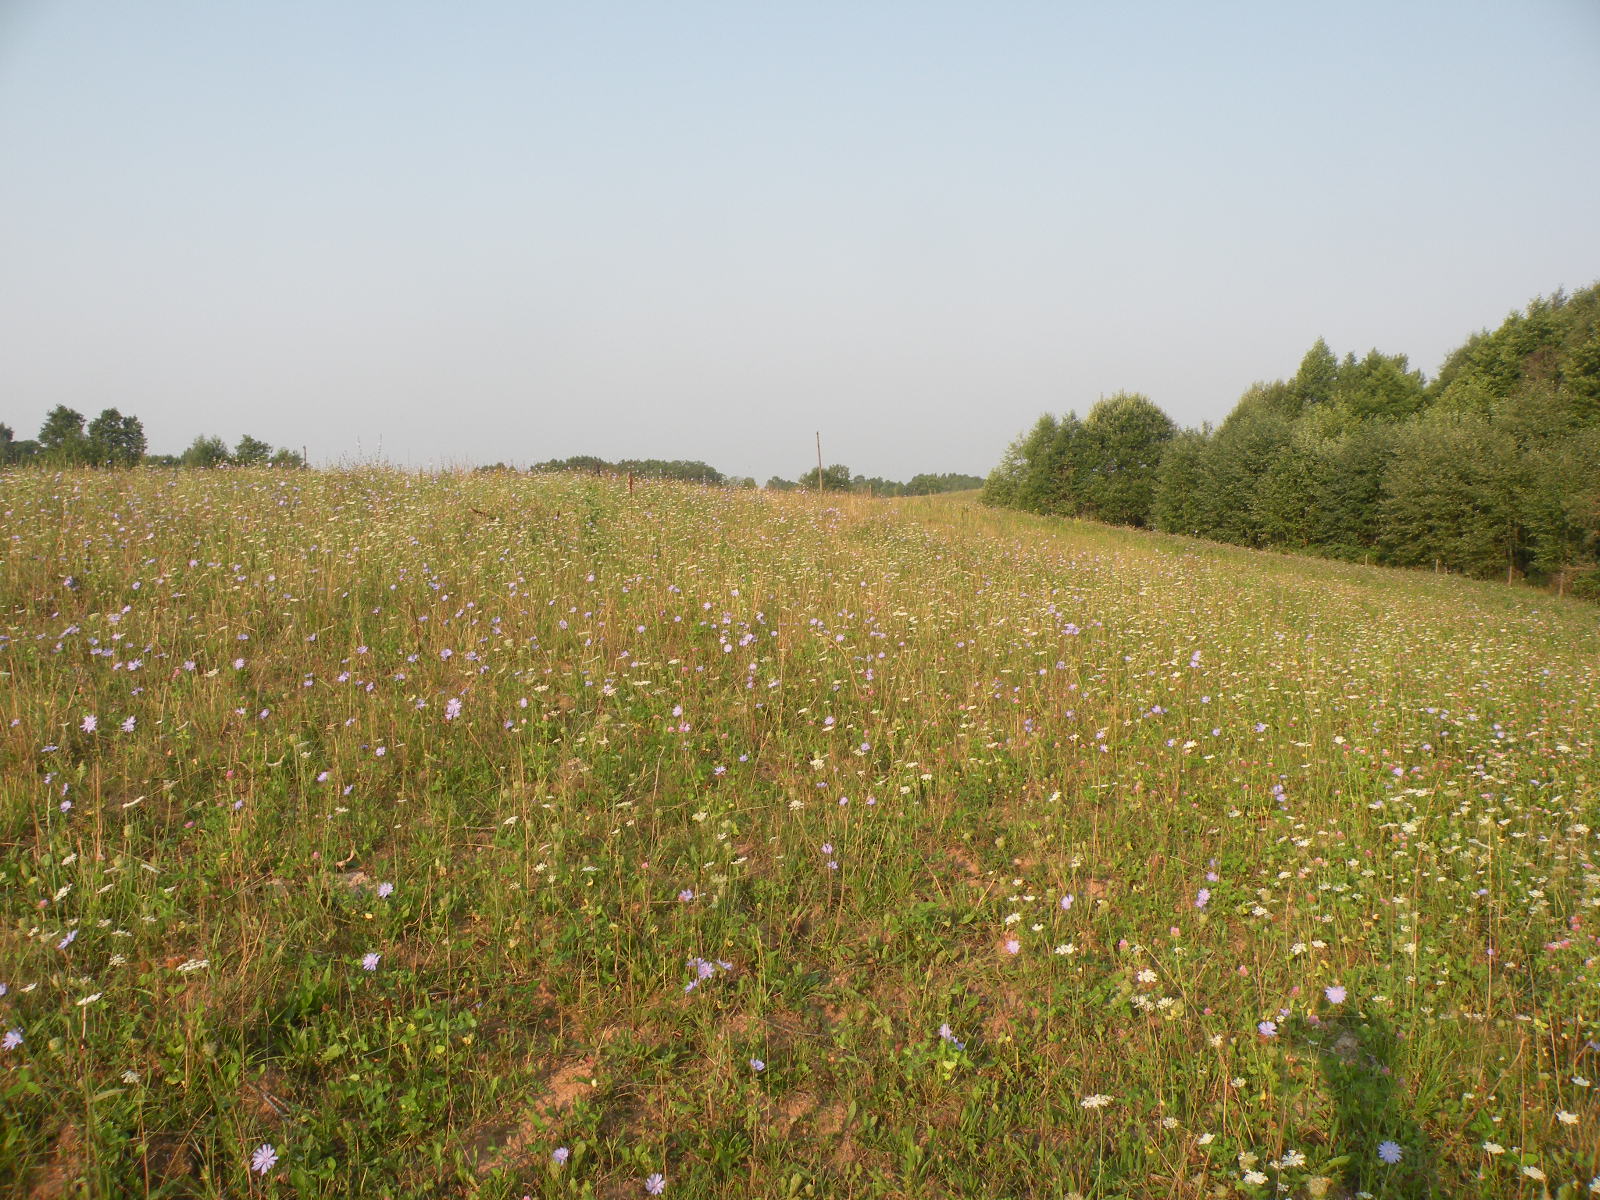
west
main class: Grassland
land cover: Grassland without tree/shrub cover
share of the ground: > 75 %
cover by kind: herbaceous plants 85 %, unconsolidated bare surface 15 %
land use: Agriculture (excluding fallow land and kitchen gardens)
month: August
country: LV
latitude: 55.7299
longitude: 26.6692
